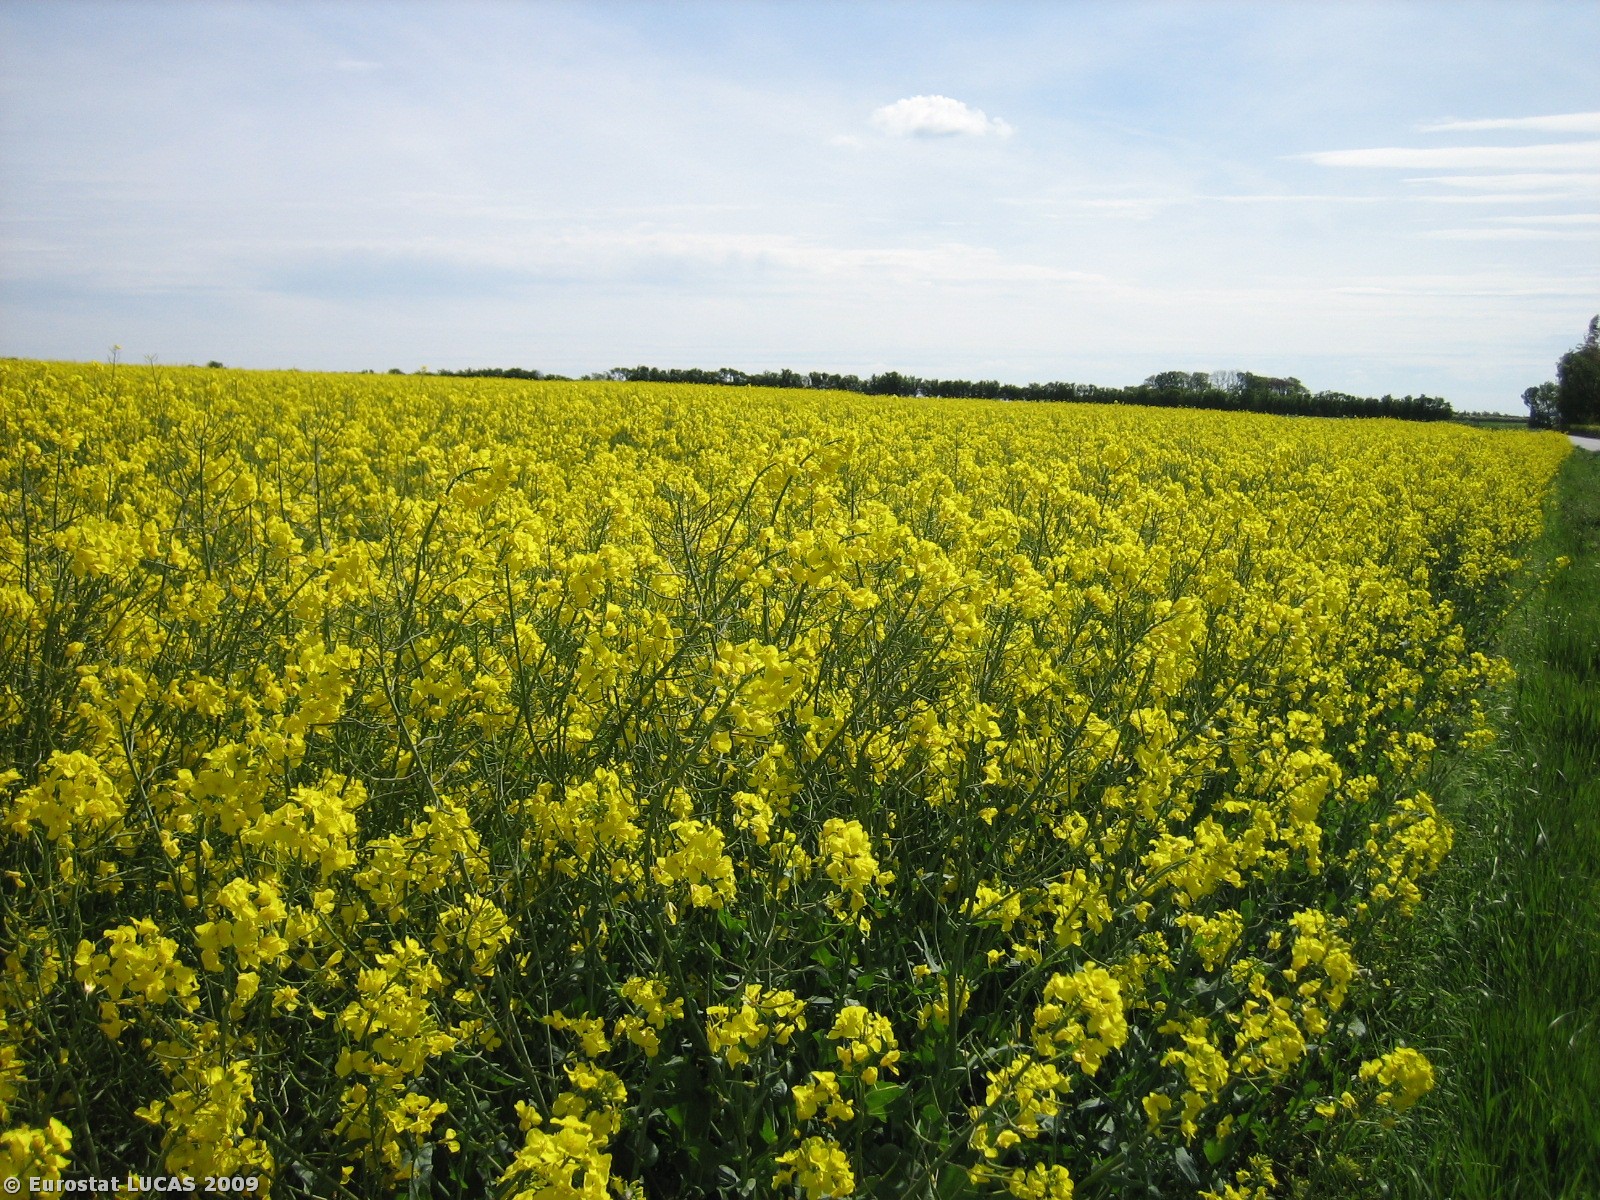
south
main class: Cropland
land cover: Rape and turnip rape
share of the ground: > 75 %
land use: Agriculture (excluding fallow land and kitchen gardens)
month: May
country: DK
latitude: 56.0177
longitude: 8.5417
